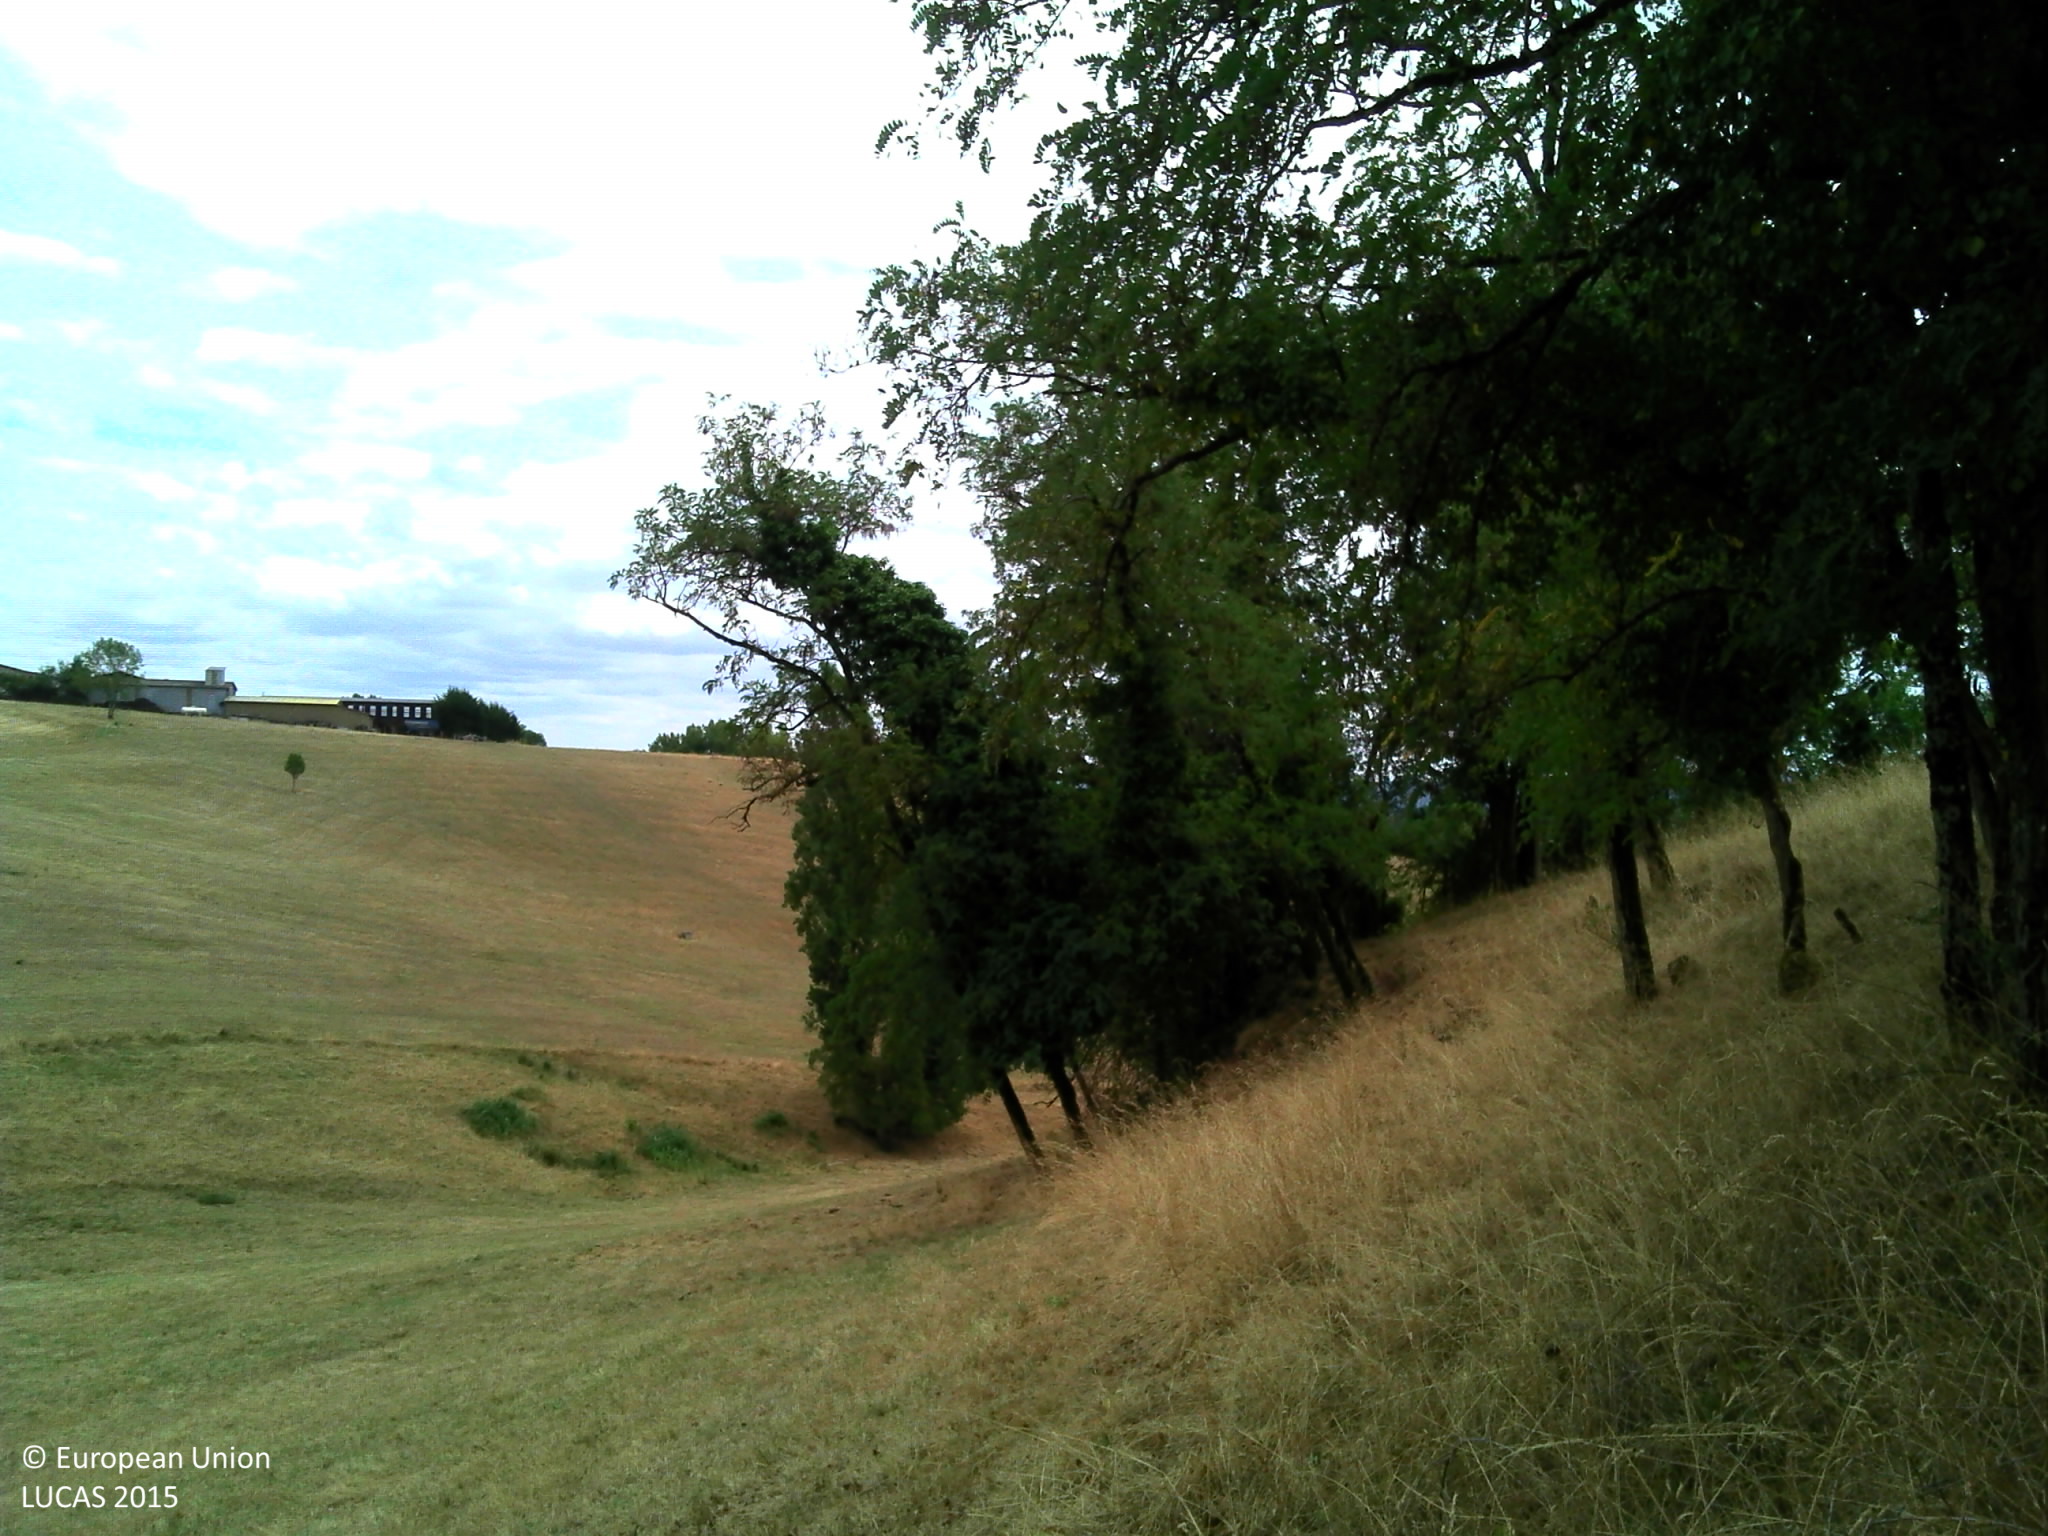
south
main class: Grassland
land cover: Grassland with sparse tree/shrub cover
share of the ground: > 75 %
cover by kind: herbaceous plants 90 %, broadleaved forest trees 5 %, lichens and mosses 5 %
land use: Agriculture (excluding fallow land and kitchen gardens)
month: July
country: FR
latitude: 45.1716
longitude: 1.4059
